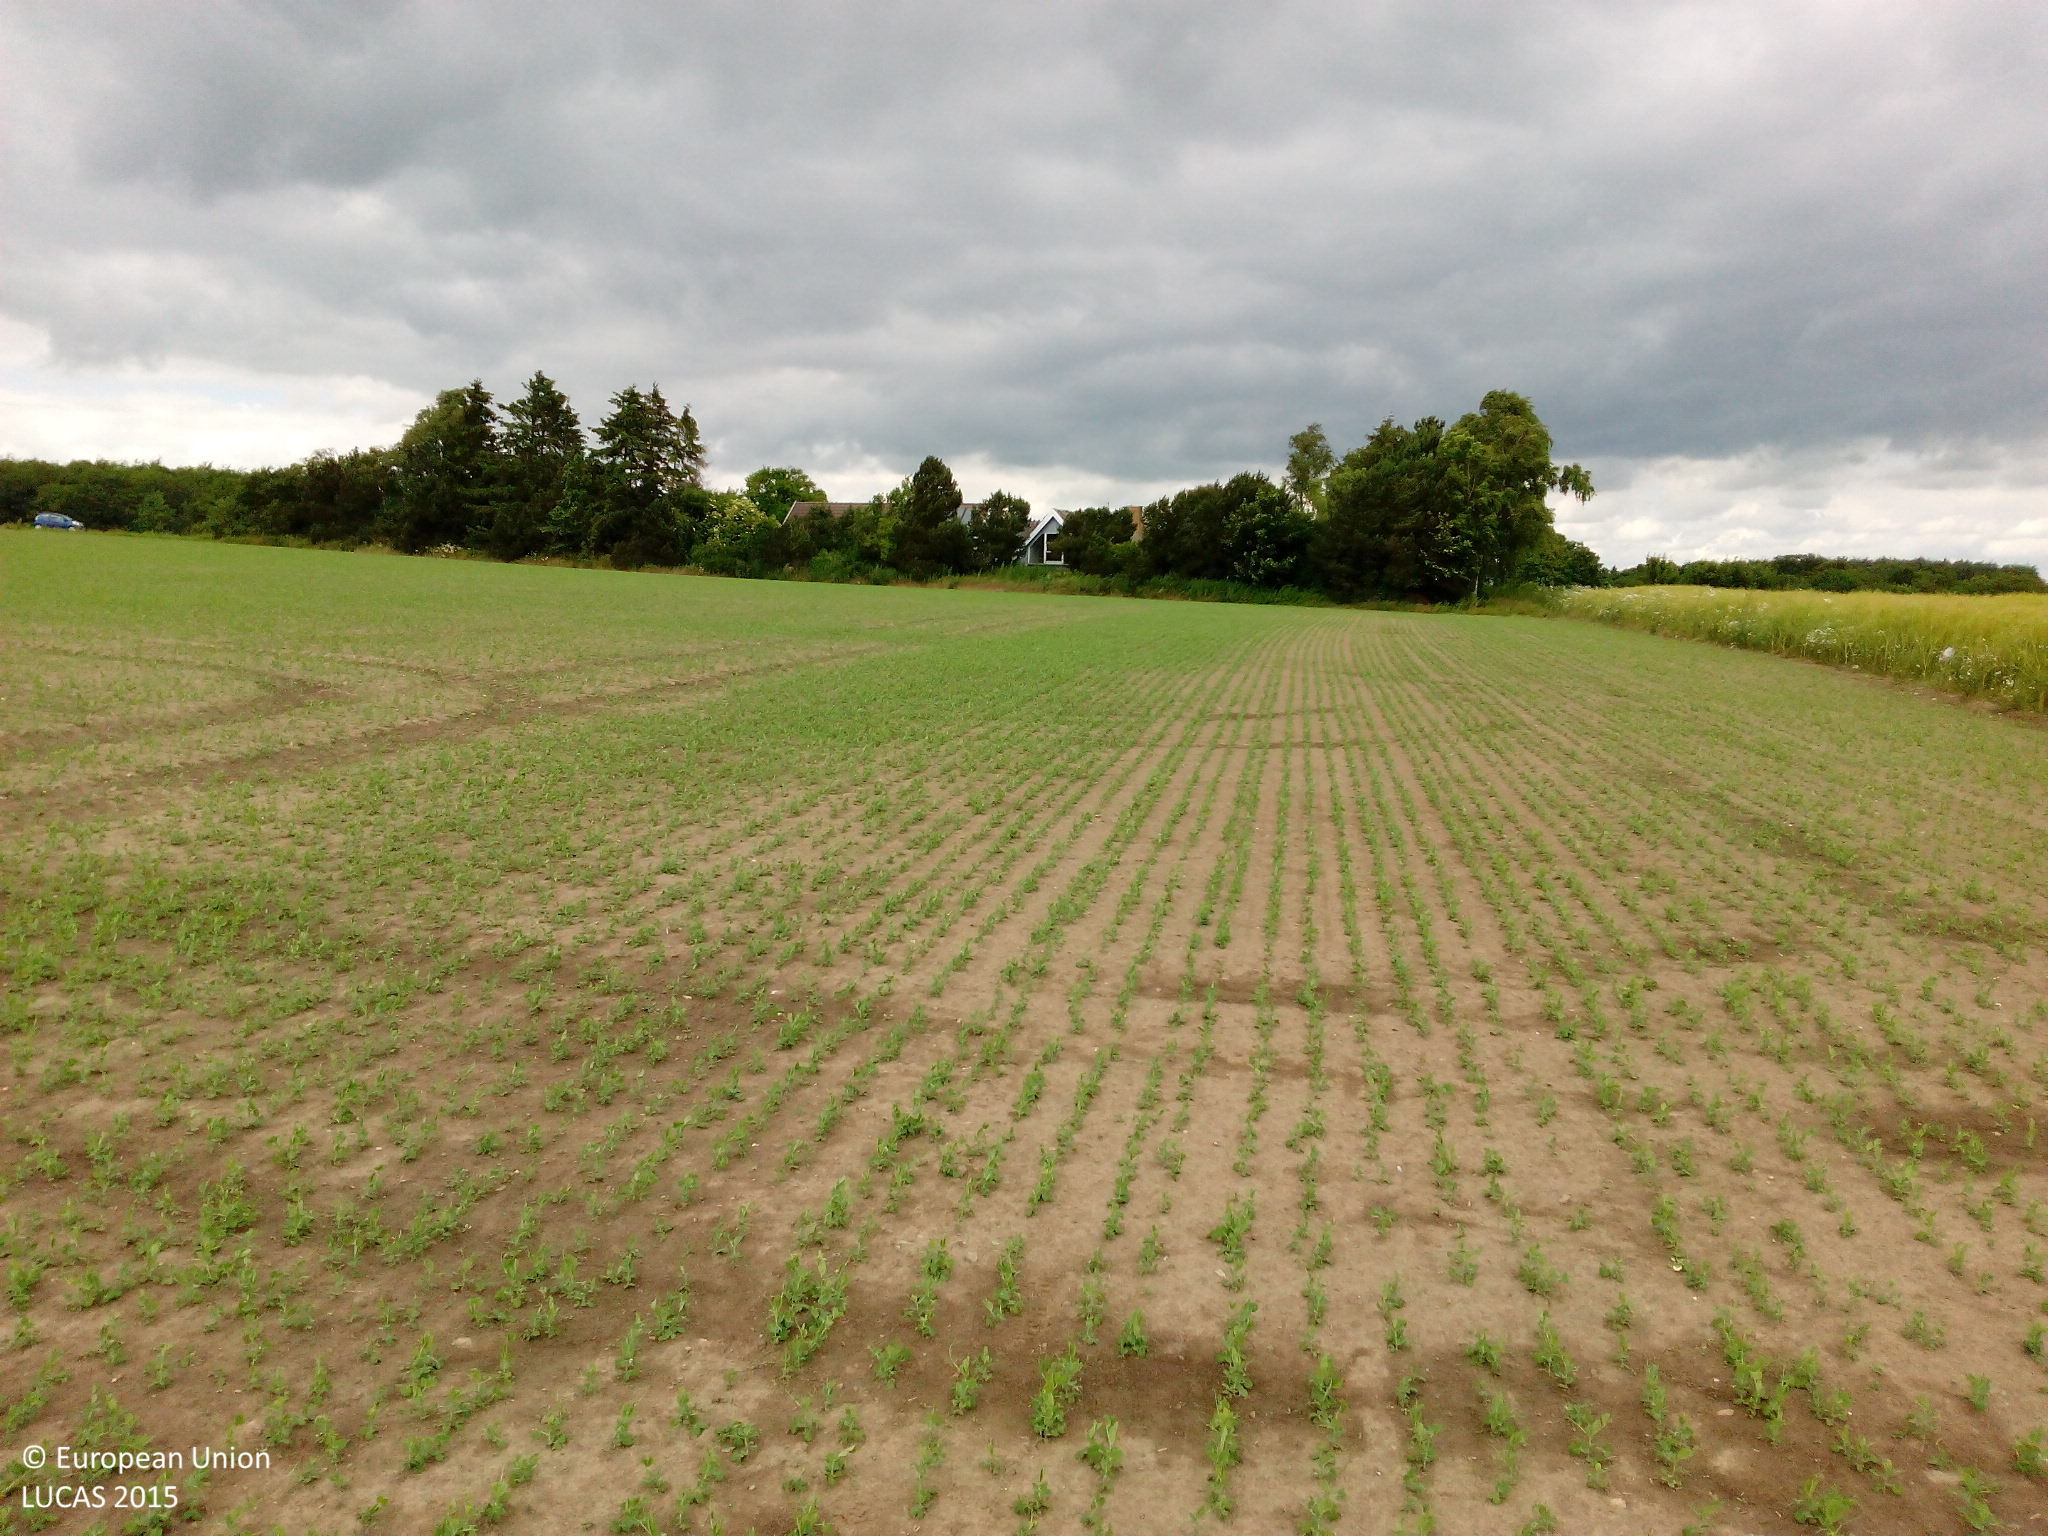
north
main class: Cropland
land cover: Dry pulses
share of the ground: > 75 %
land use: Agriculture (excluding fallow land and kitchen gardens)
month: July
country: DK
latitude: 55.2537
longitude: 12.0909
